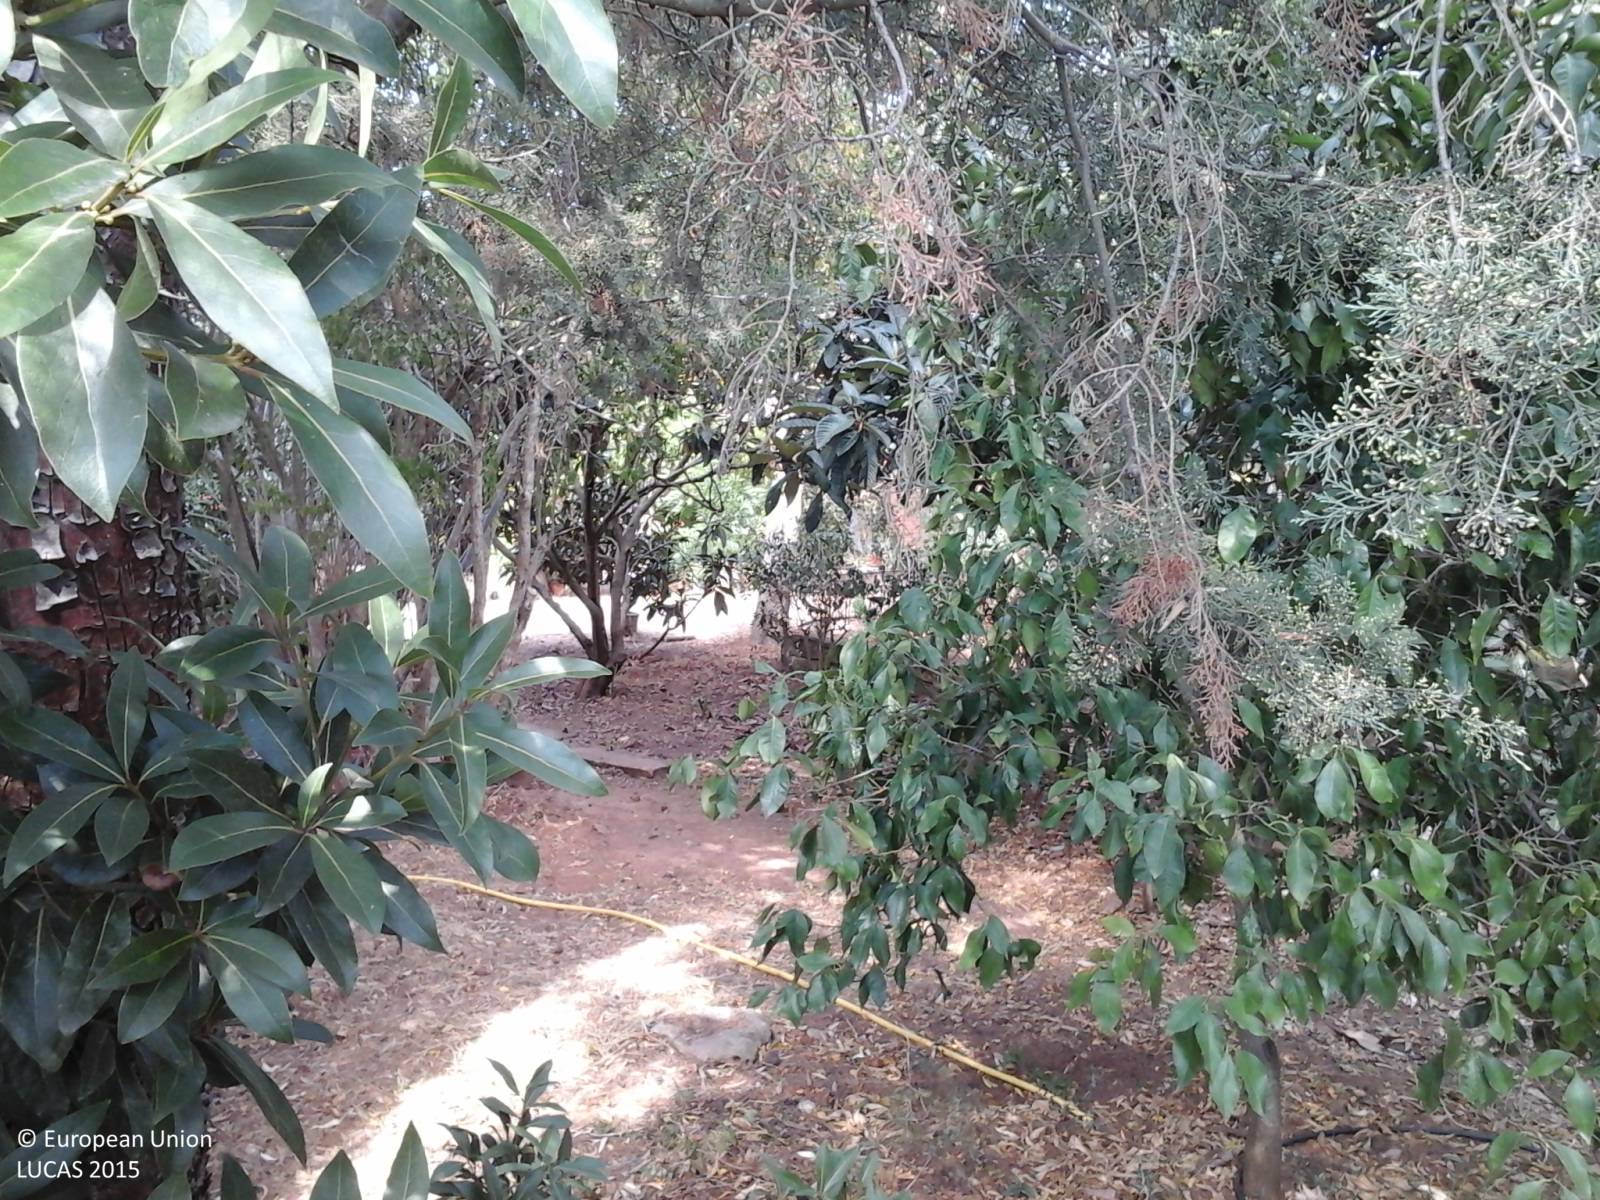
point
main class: Cropland
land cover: Other fruit trees and berries
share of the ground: 25 - 50 %
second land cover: Grassland without tree/shrub cover
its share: 10 - 25 %
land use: Kitchen garden
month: May
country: IT
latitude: 40.7258
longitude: 8.4564
